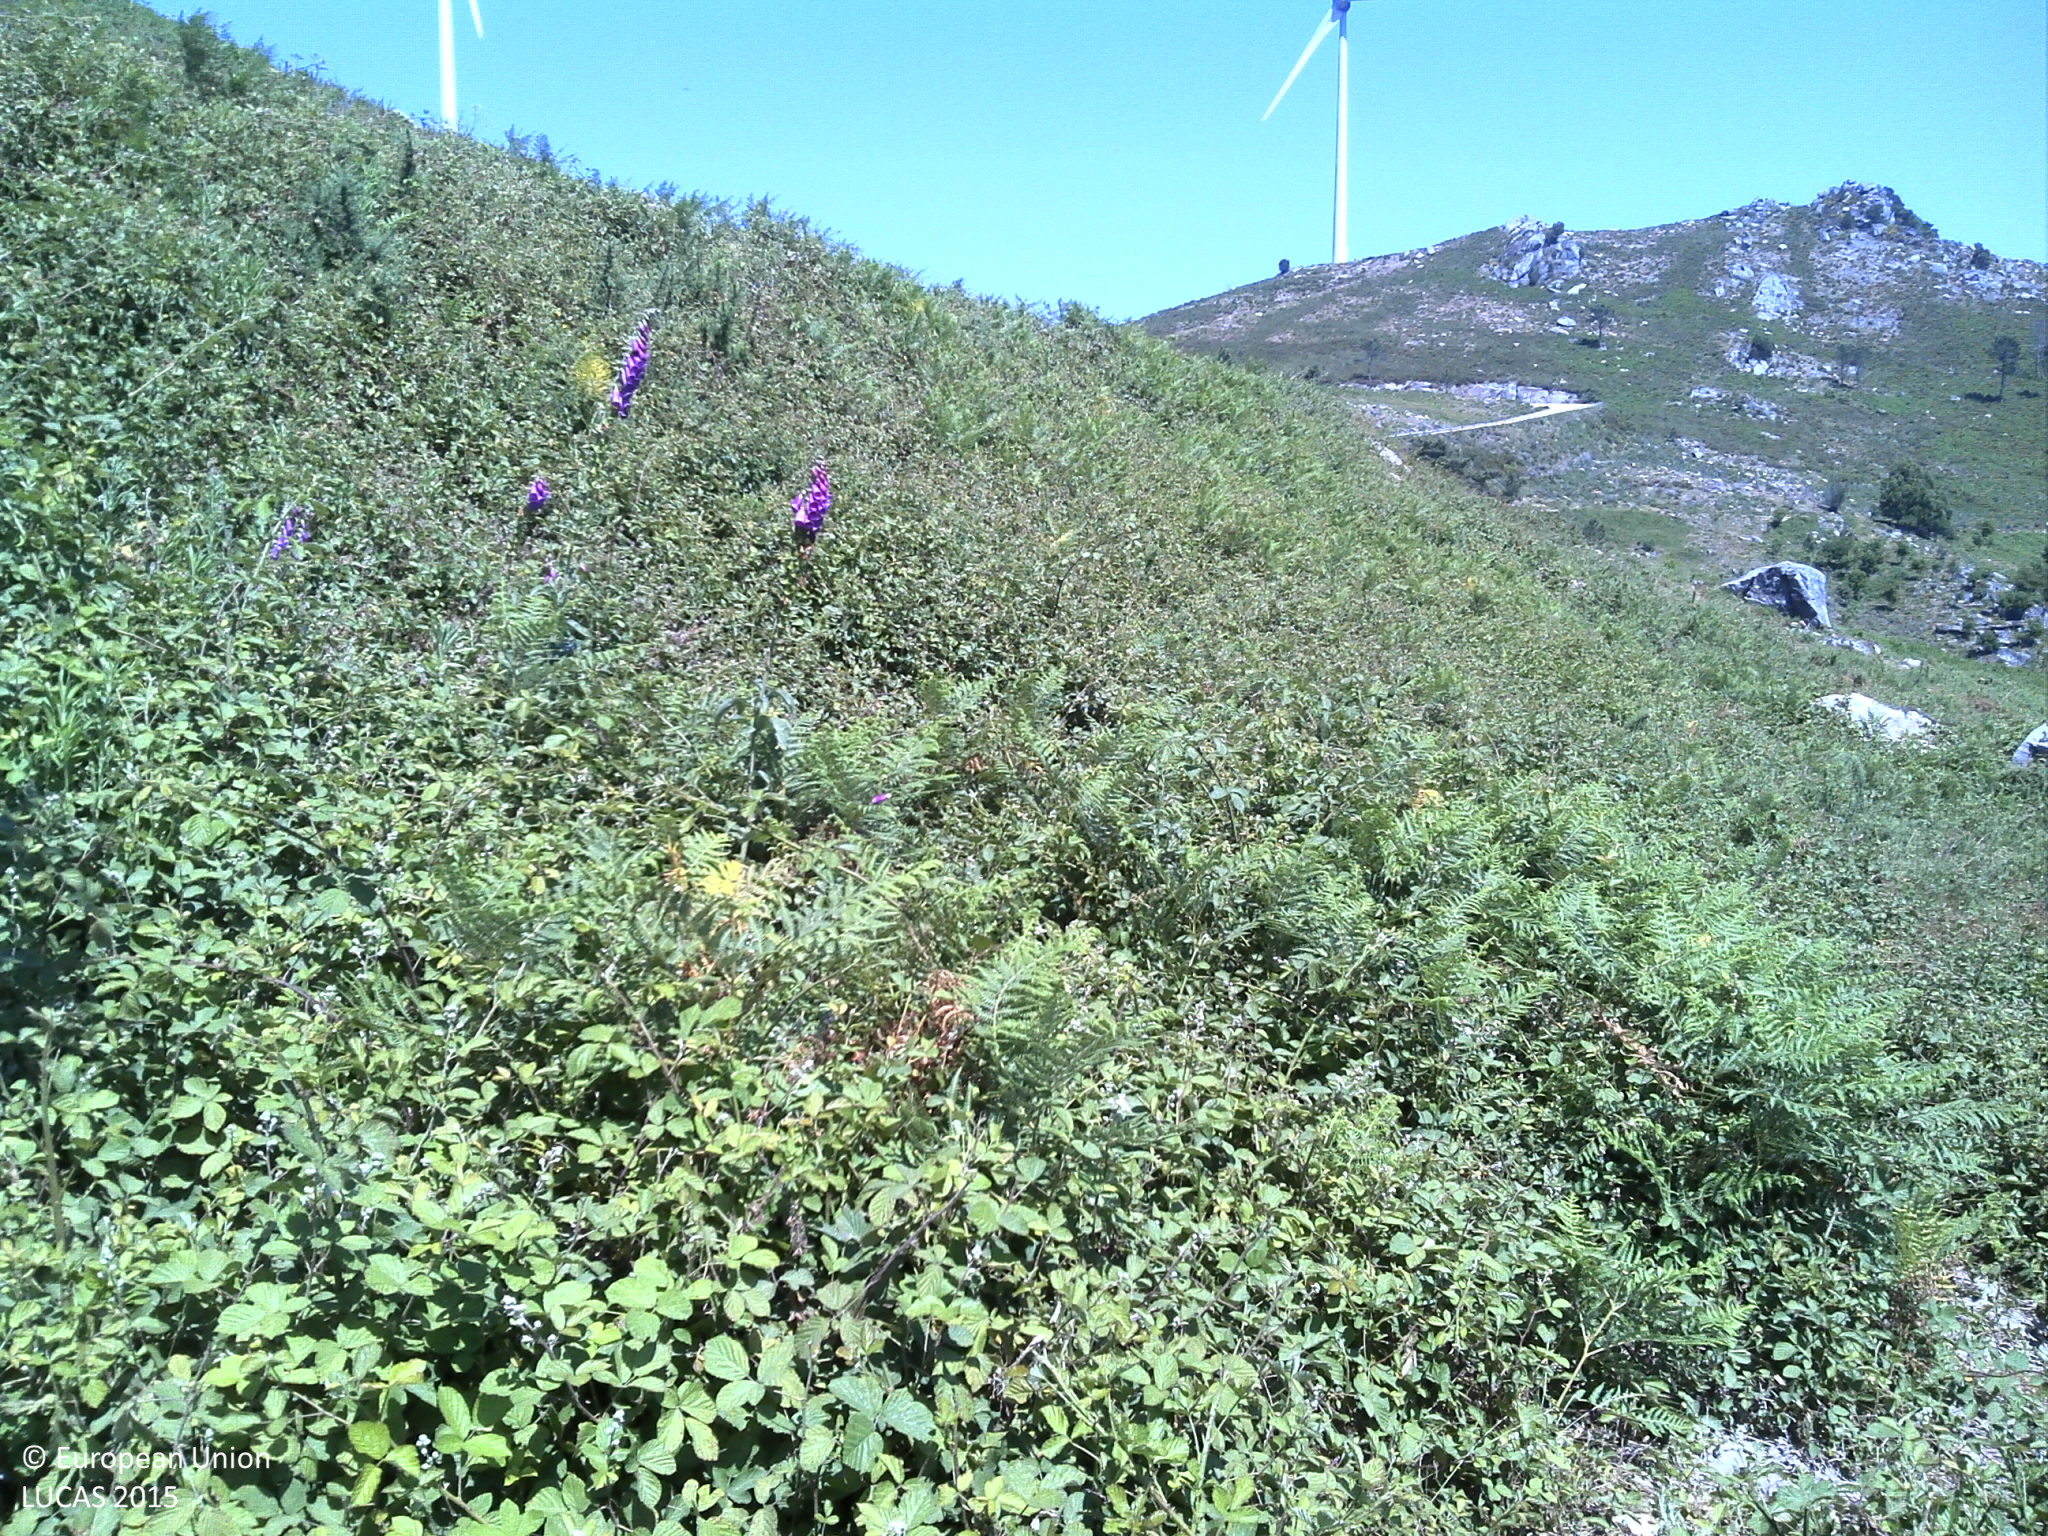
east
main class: Shrubland
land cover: Shrubland without tree cover
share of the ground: > 75 %
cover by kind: shrubs 80 %, herbaceous plants 10 %, unconsolidated bare surface 10 %
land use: Semi-natural and natural areas not in use
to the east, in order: Shrubland without tree cover; Tracks; Shrubland without tree cover; Shrubland with sparse tree cover; Dry stone walls; Pine dominated coniferous woodland; Pine dominated mixed woodland; Dry stone walls; Shrubland without tree cover
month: June
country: PT
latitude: 41.9991
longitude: -8.4270
